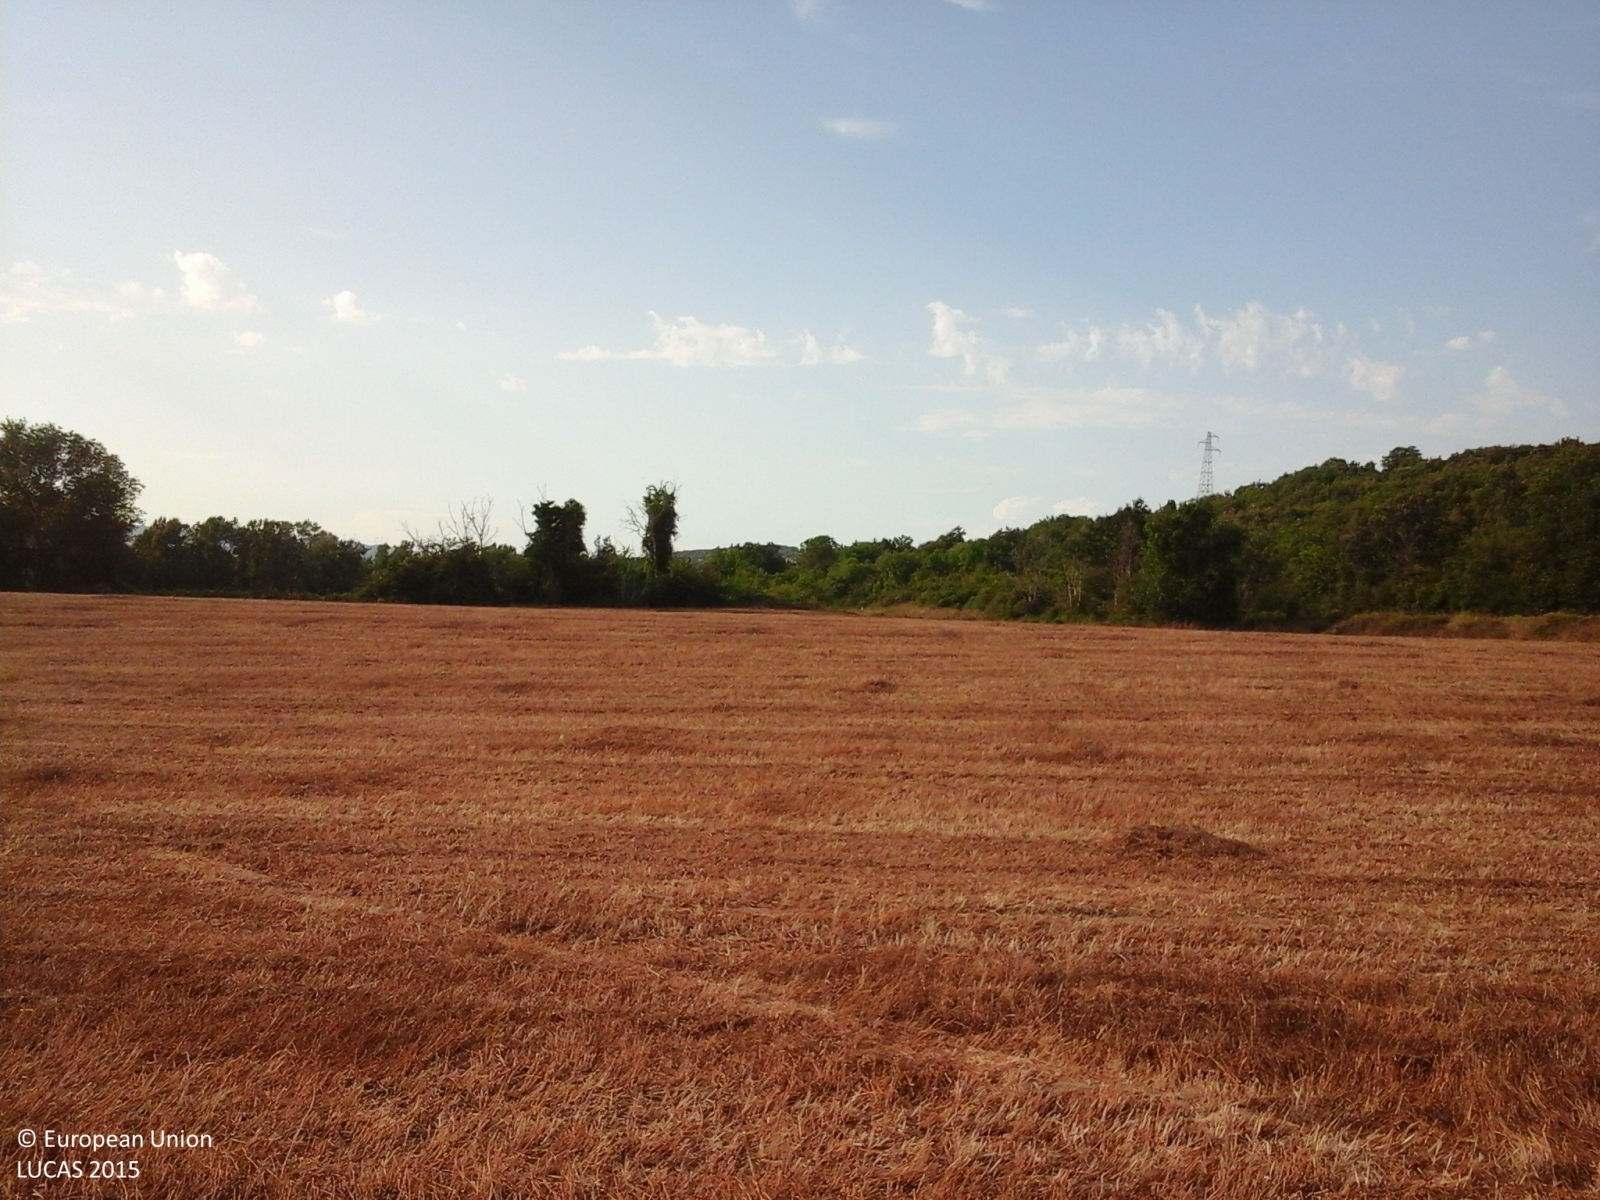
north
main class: Cropland
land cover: Durum wheat
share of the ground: > 75 %
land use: Agriculture (excluding fallow land and kitchen gardens)
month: July
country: IT
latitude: 43.2836
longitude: 10.7004
